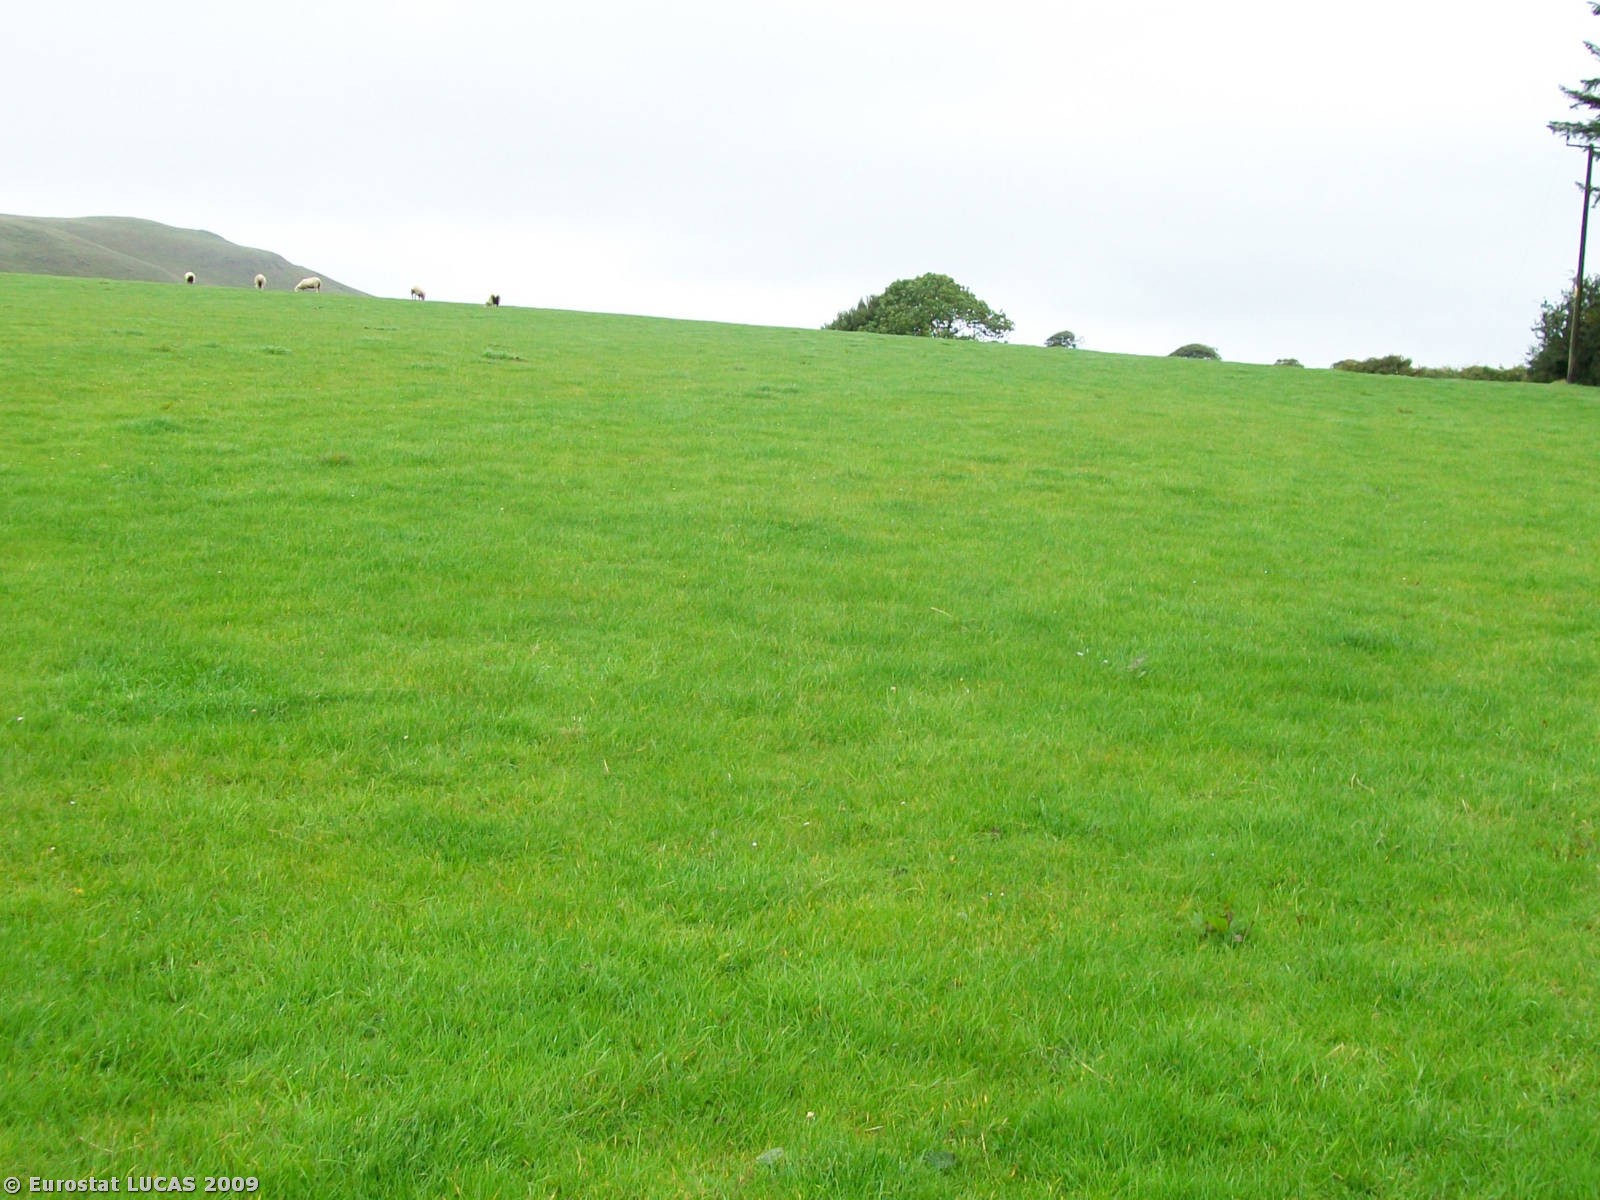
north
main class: Grassland
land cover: Grassland without tree/shrub cover
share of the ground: < 10 %
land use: Agriculture (excluding fallow land and kitchen gardens)
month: August
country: GB
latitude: 55.1876
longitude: -4.8578
